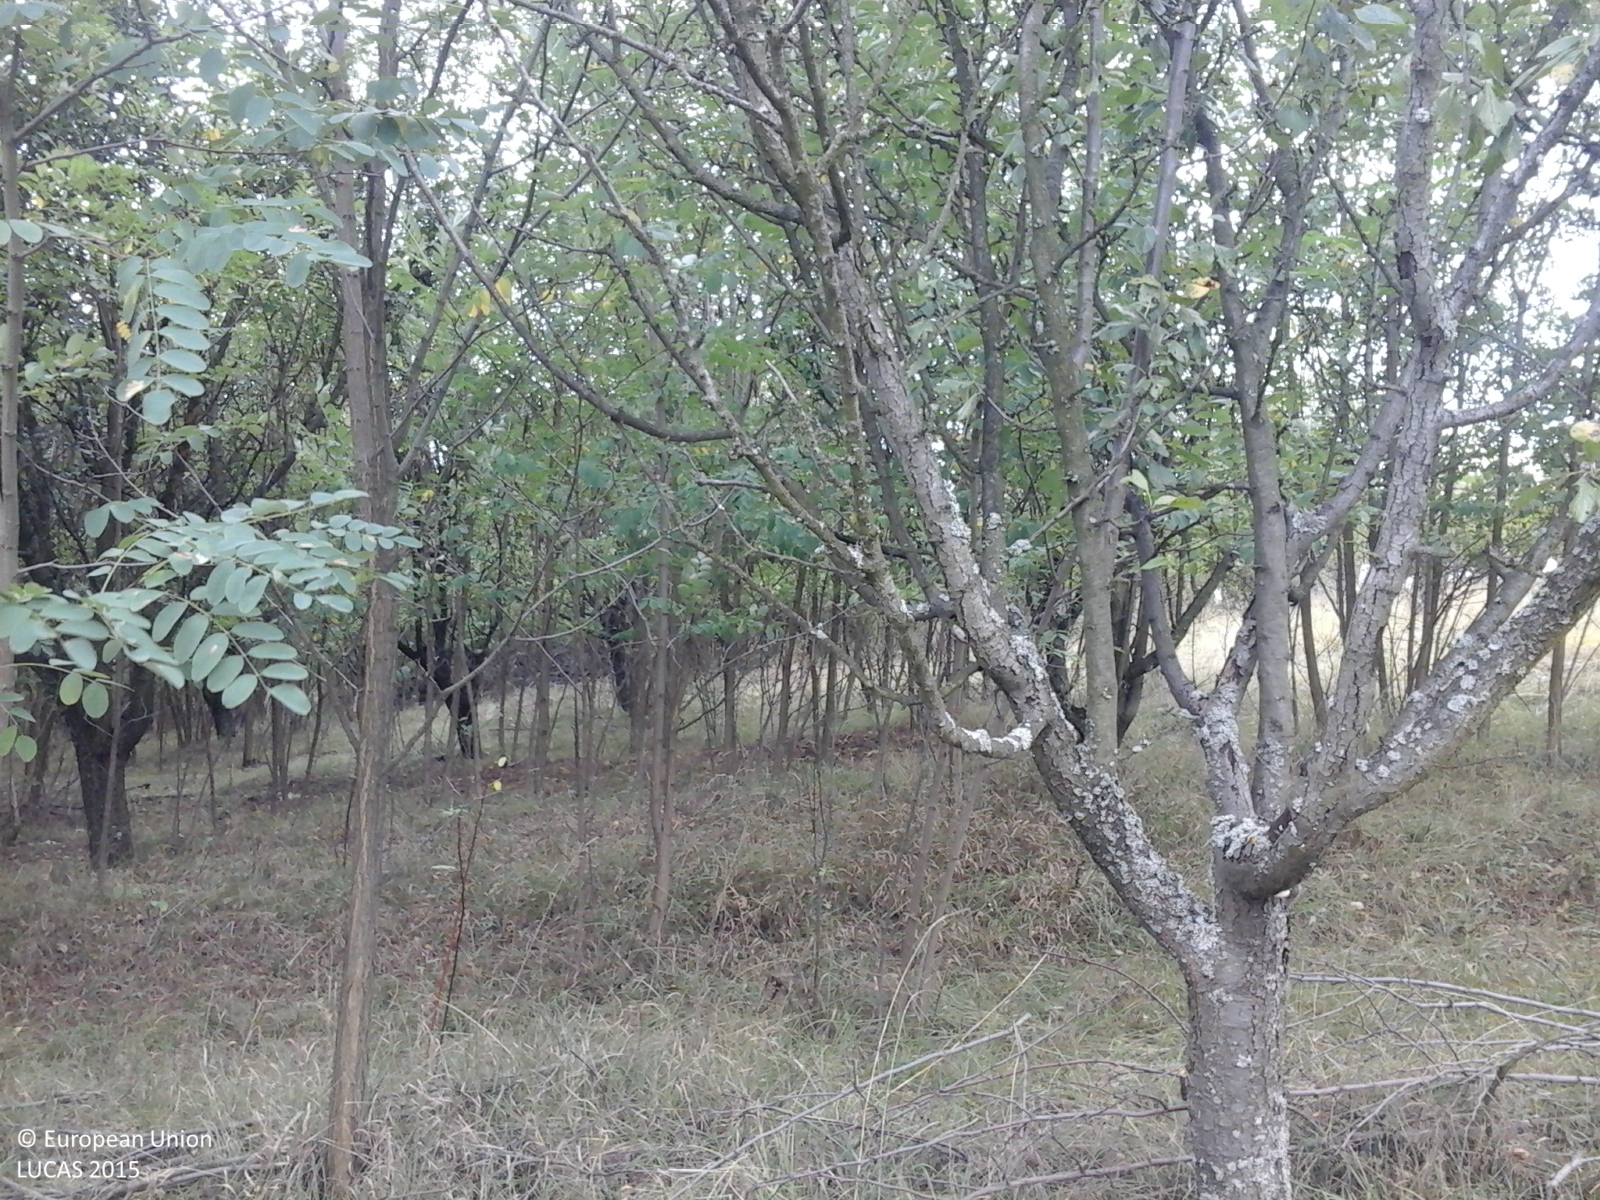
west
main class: Cropland
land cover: Other fruit trees and berries
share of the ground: 50 - 75 %
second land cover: Grassland without tree/shrub cover
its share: > 75 %
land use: Agriculture (excluding fallow land and kitchen gardens)
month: September
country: RO
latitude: 45.9779
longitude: 23.6848
